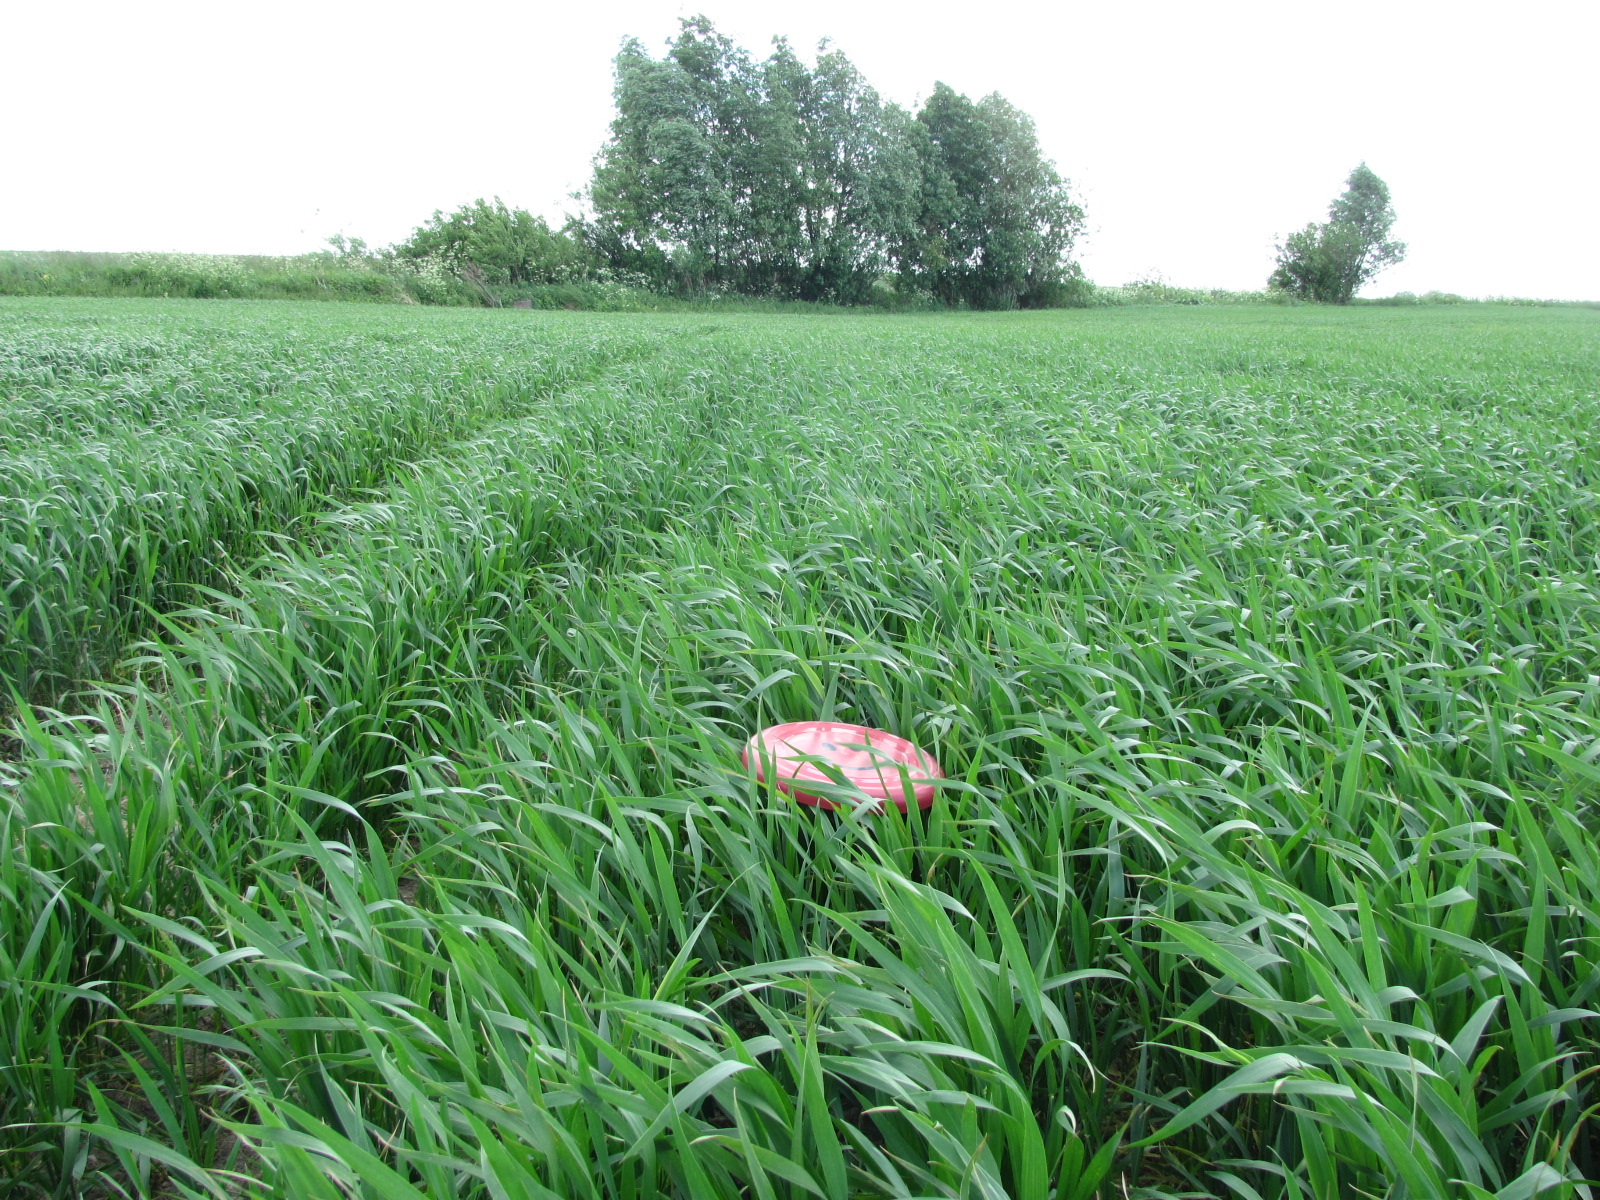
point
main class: Cropland
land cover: Common wheat
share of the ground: > 75 %
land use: Agriculture (excluding fallow land and kitchen gardens)
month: June
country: LV
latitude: 56.2542
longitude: 24.1811
